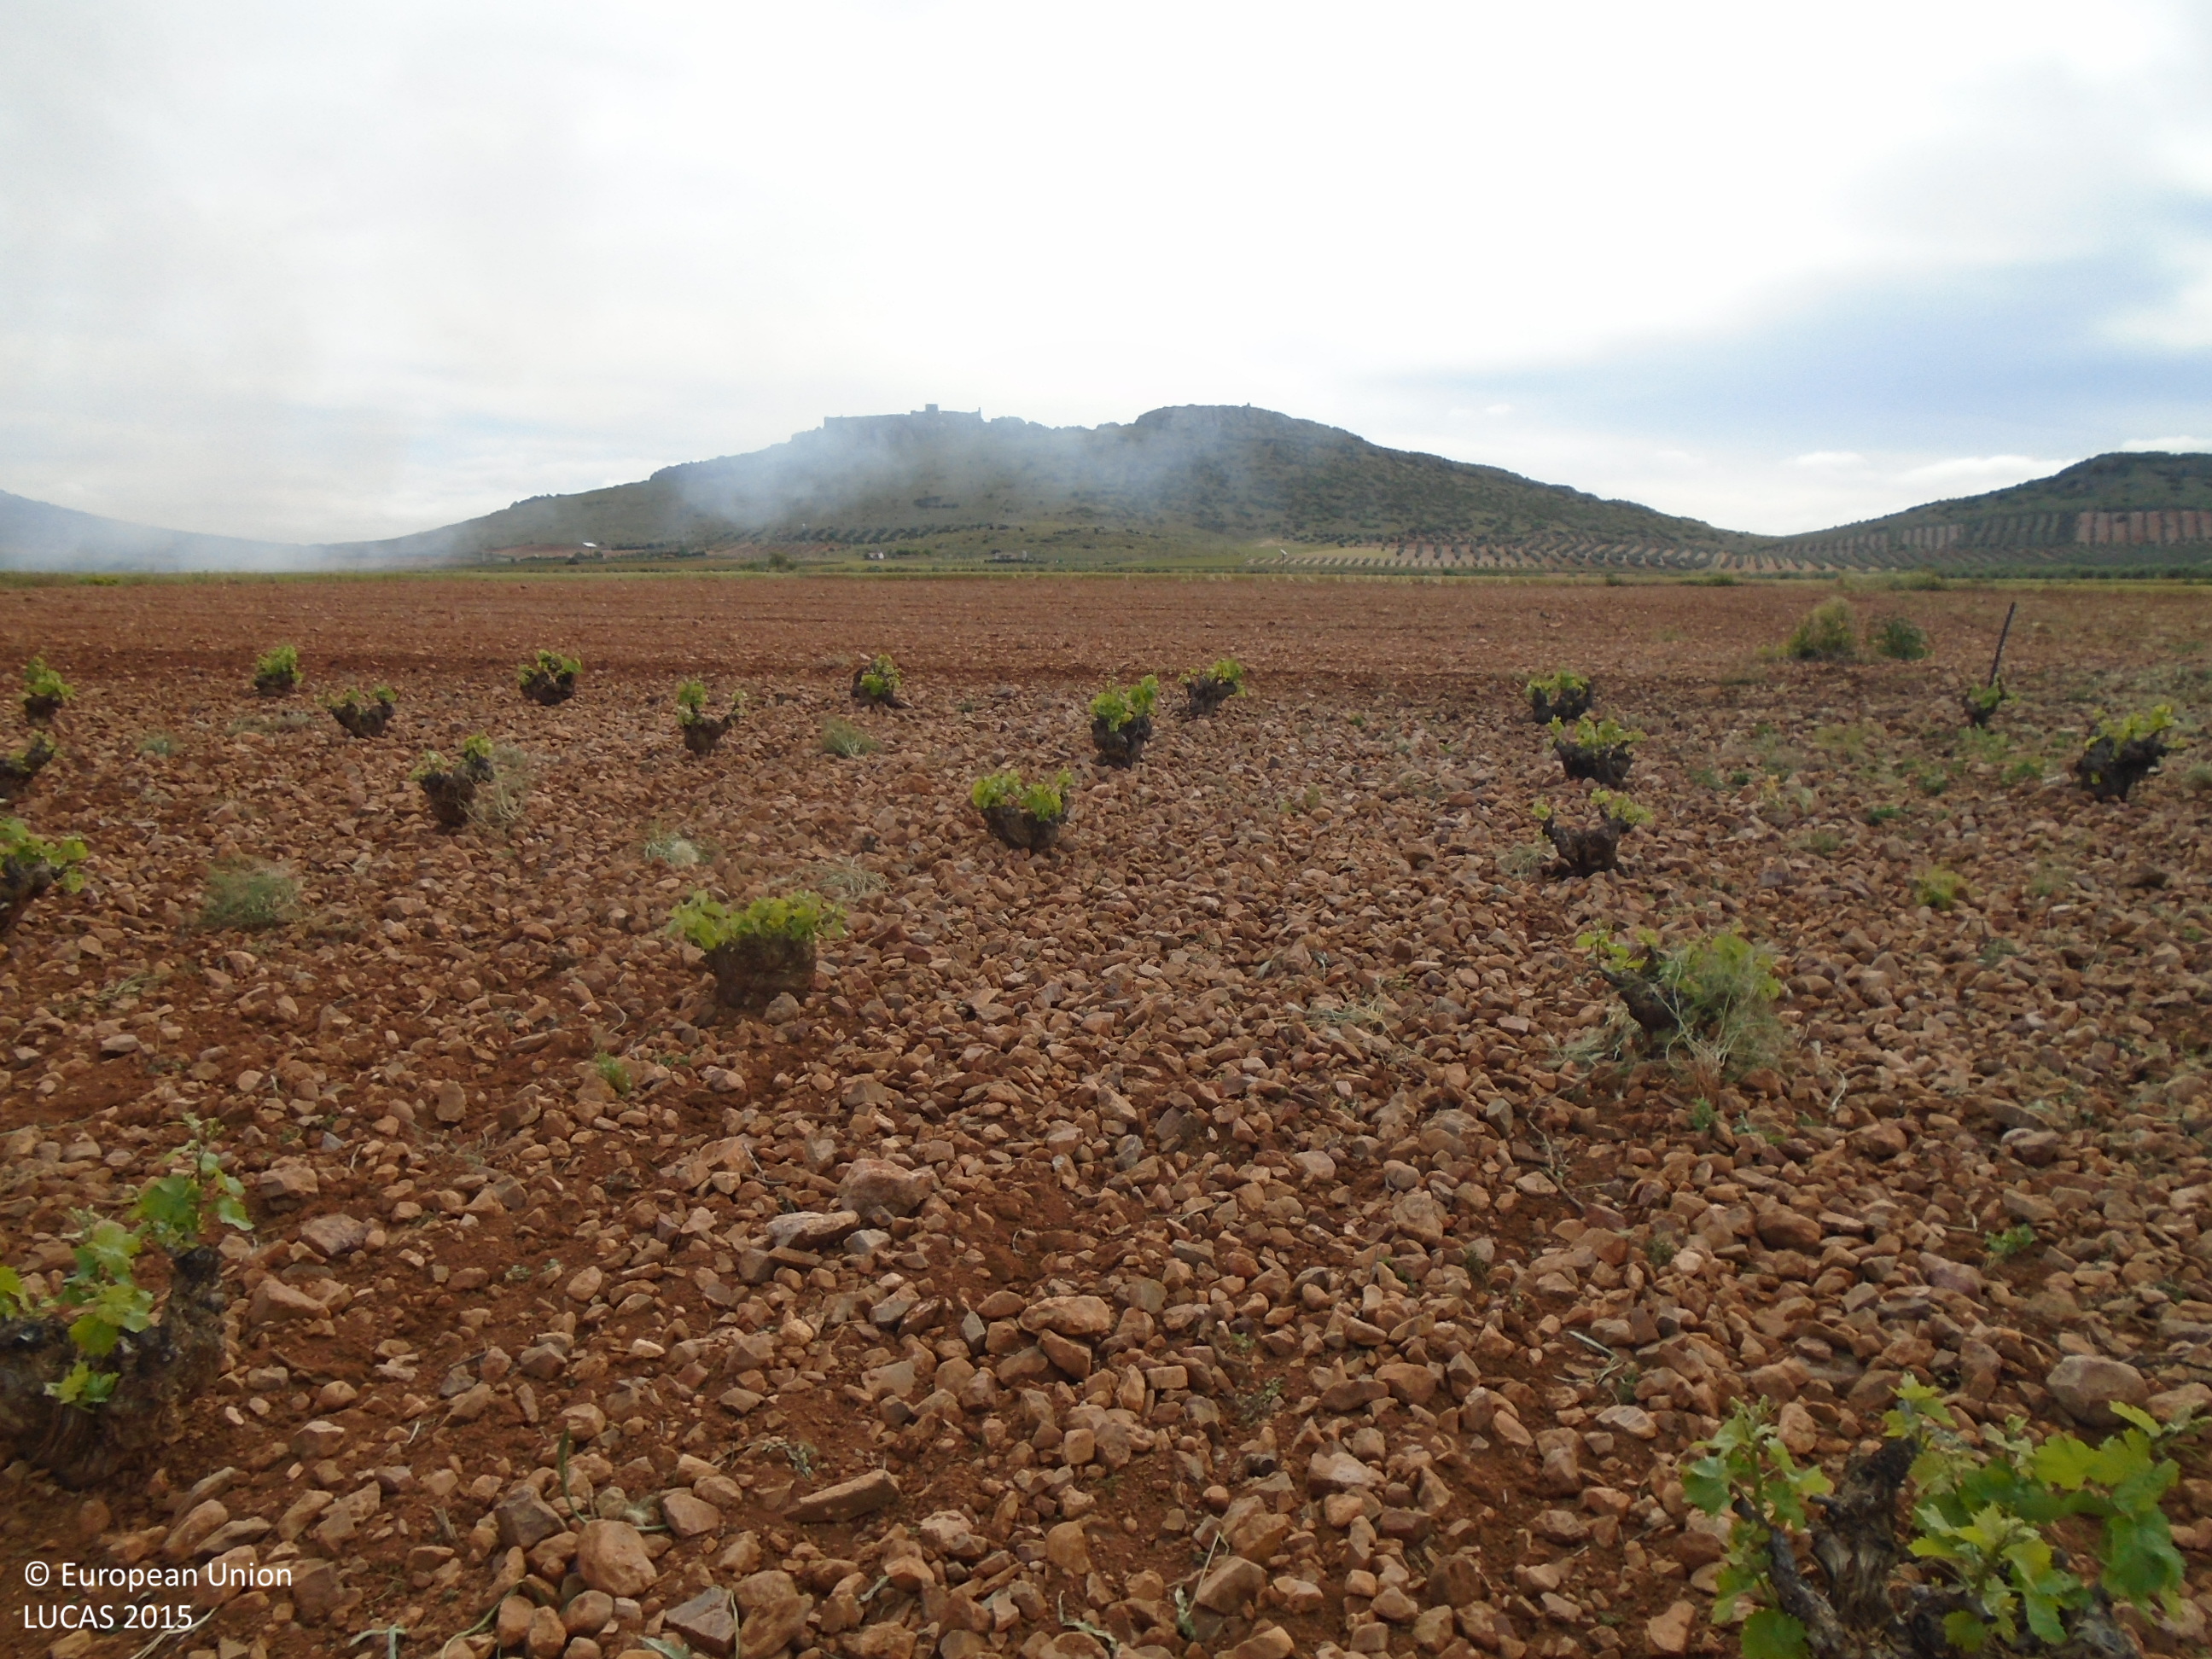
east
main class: Cropland
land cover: Vineyards
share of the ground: 10 - 25 %
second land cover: Other bare soil
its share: > 75 %
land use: Agriculture (excluding fallow land and kitchen gardens)
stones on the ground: > 50 %
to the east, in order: Vineyards; Other bare soil; Grass margins; Barley; Grass margins; Barley; Grass margins; Vineyards; Grass margins; Olive groves
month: May
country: ES
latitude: 39.6788
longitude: -3.7507
